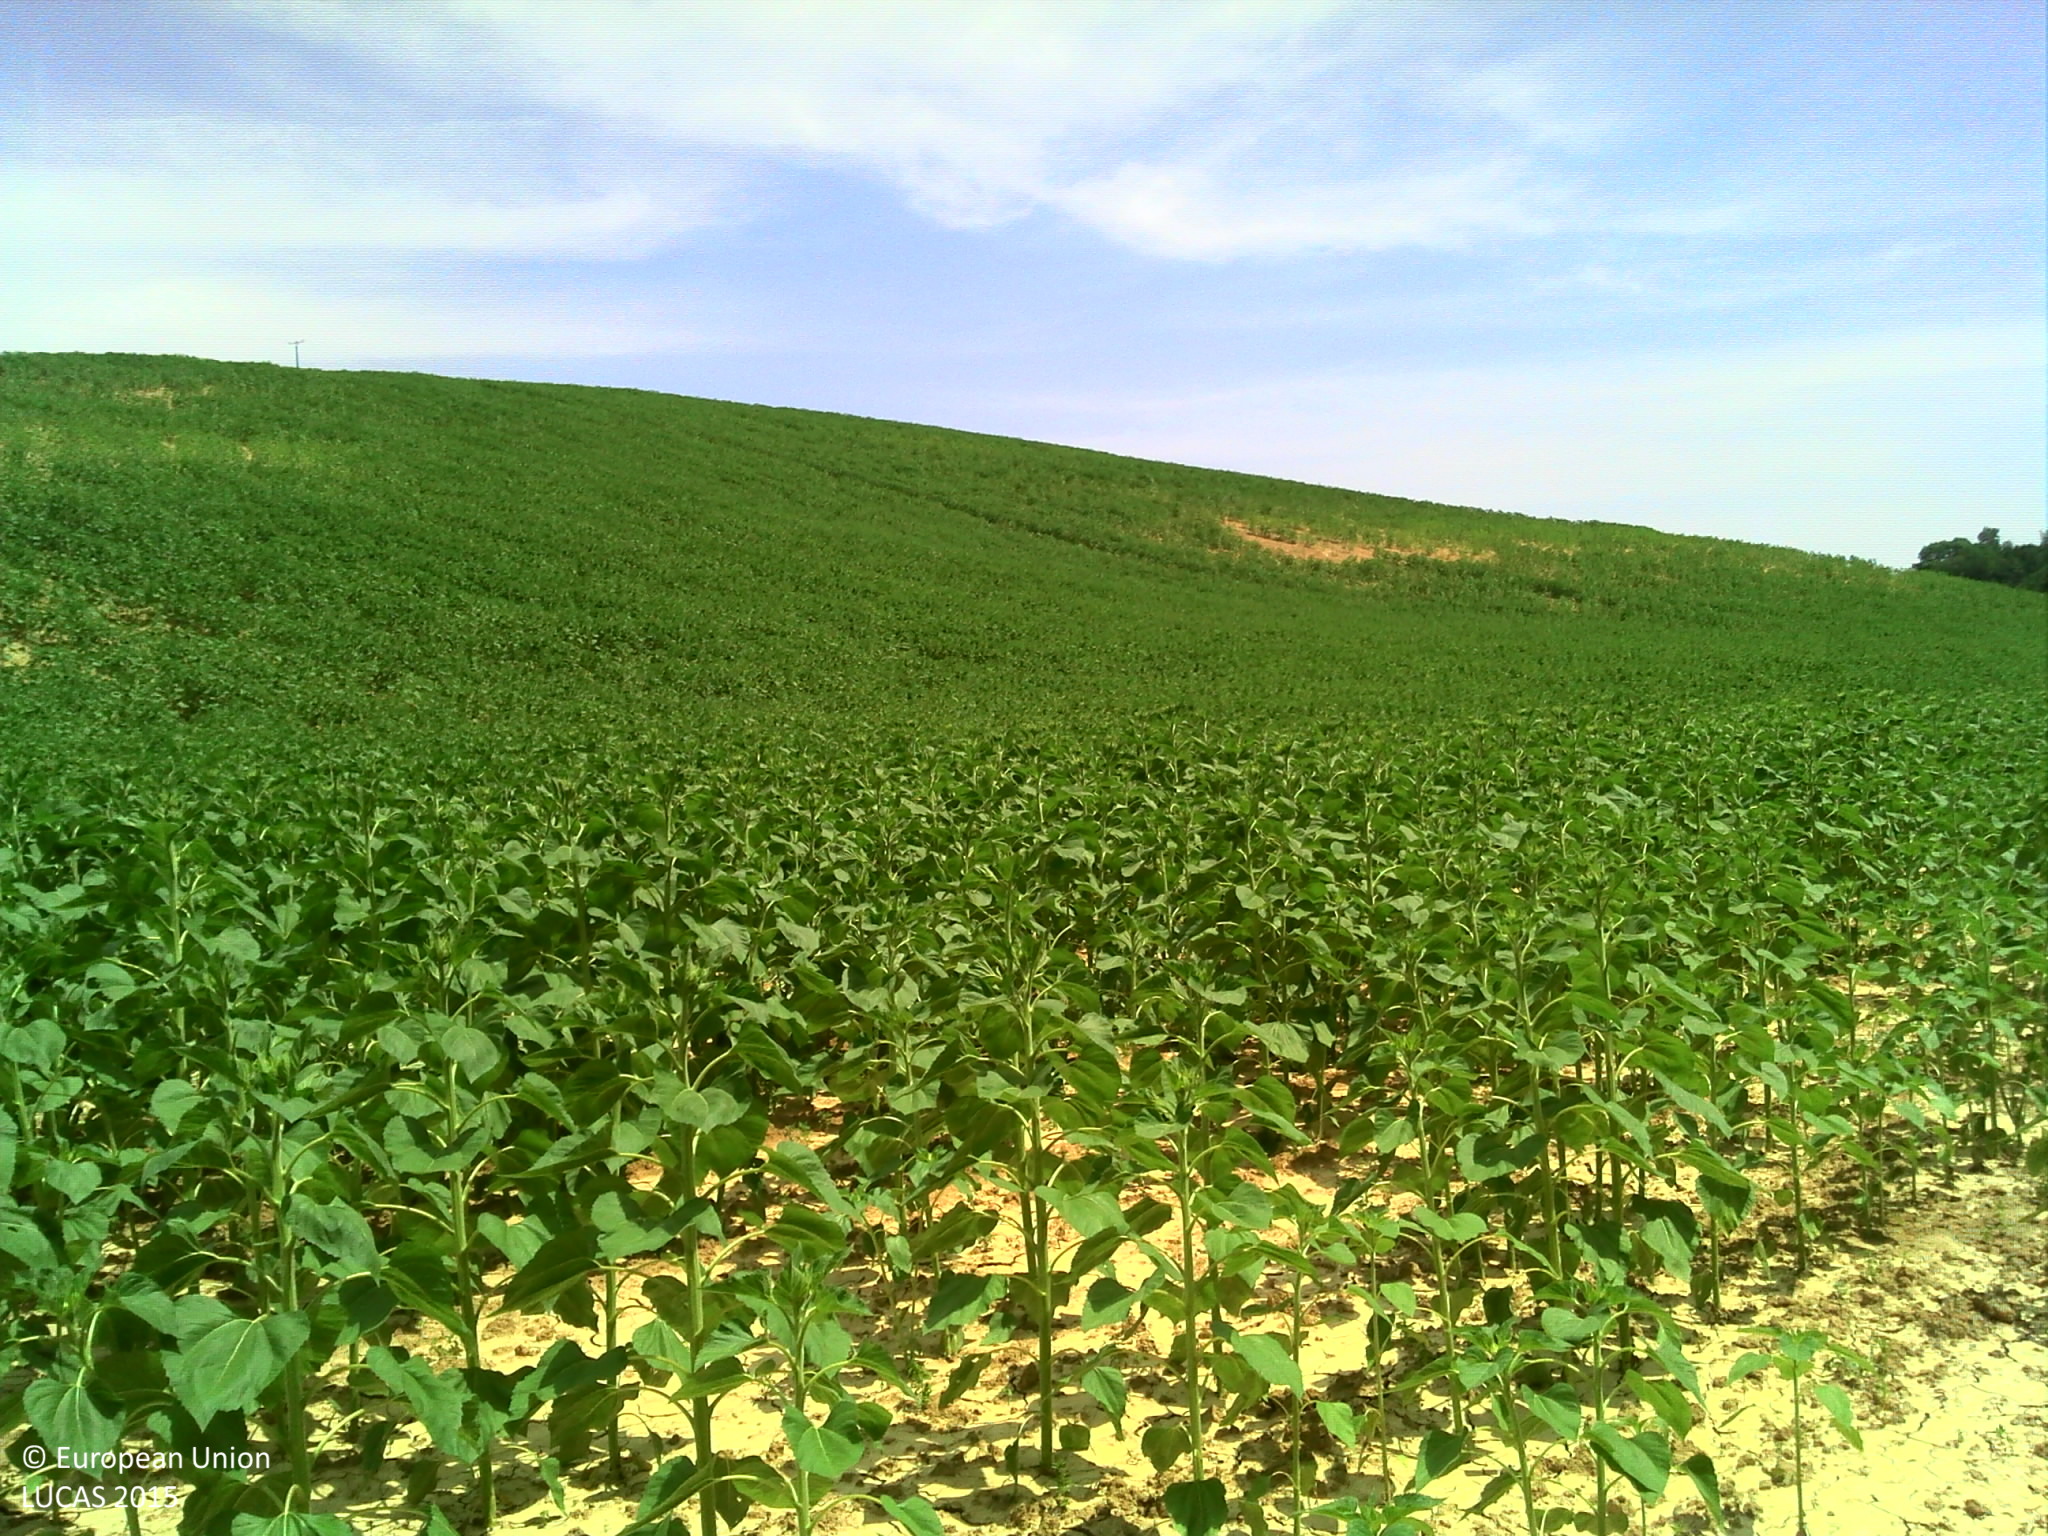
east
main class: Cropland
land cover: Sunflower
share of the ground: > 75 %
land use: Agriculture (excluding fallow land and kitchen gardens)
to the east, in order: Sunflower
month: July
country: FR
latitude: 43.5282
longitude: 1.0552
